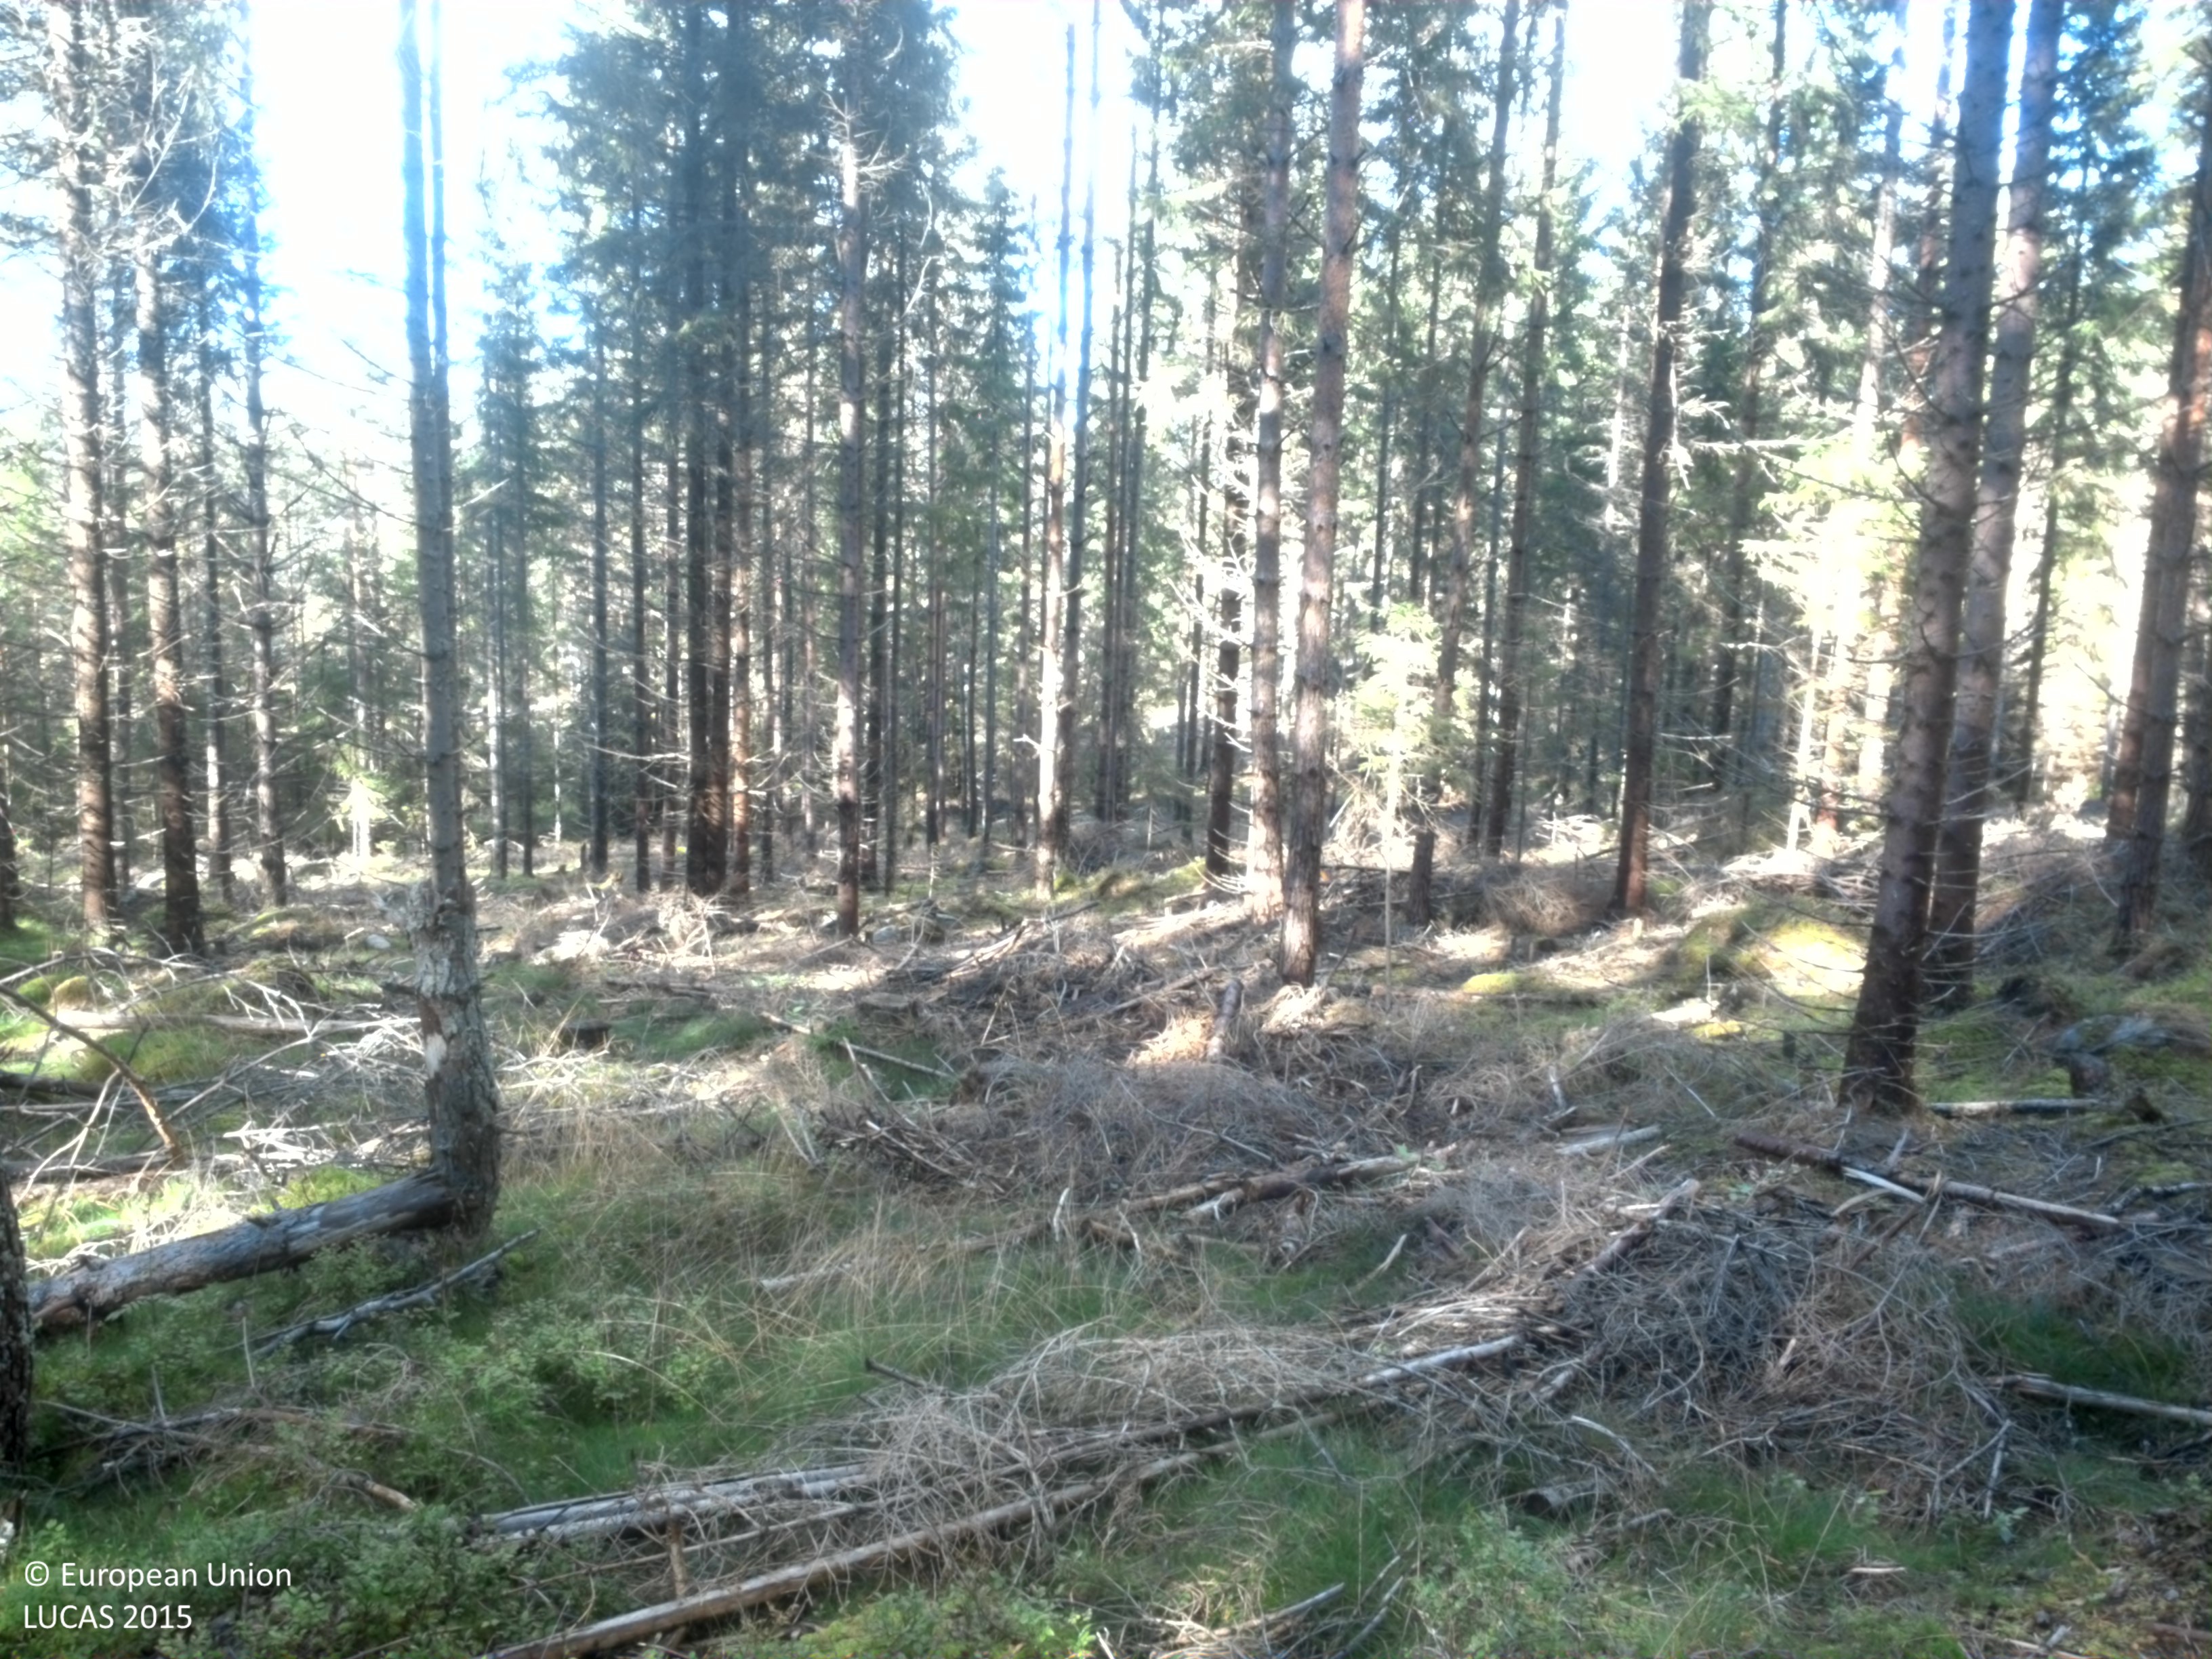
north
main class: Woodland
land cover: Other coniferous woodland
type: boreal forest
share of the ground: > 75 %
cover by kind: coniferous forest trees 75 %, shrubs 10 %, lichens and mosses 10 %, herbaceous plants 5 %
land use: Forestry
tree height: > 5 m
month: September
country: SE
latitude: 59.8925
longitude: 15.5123
